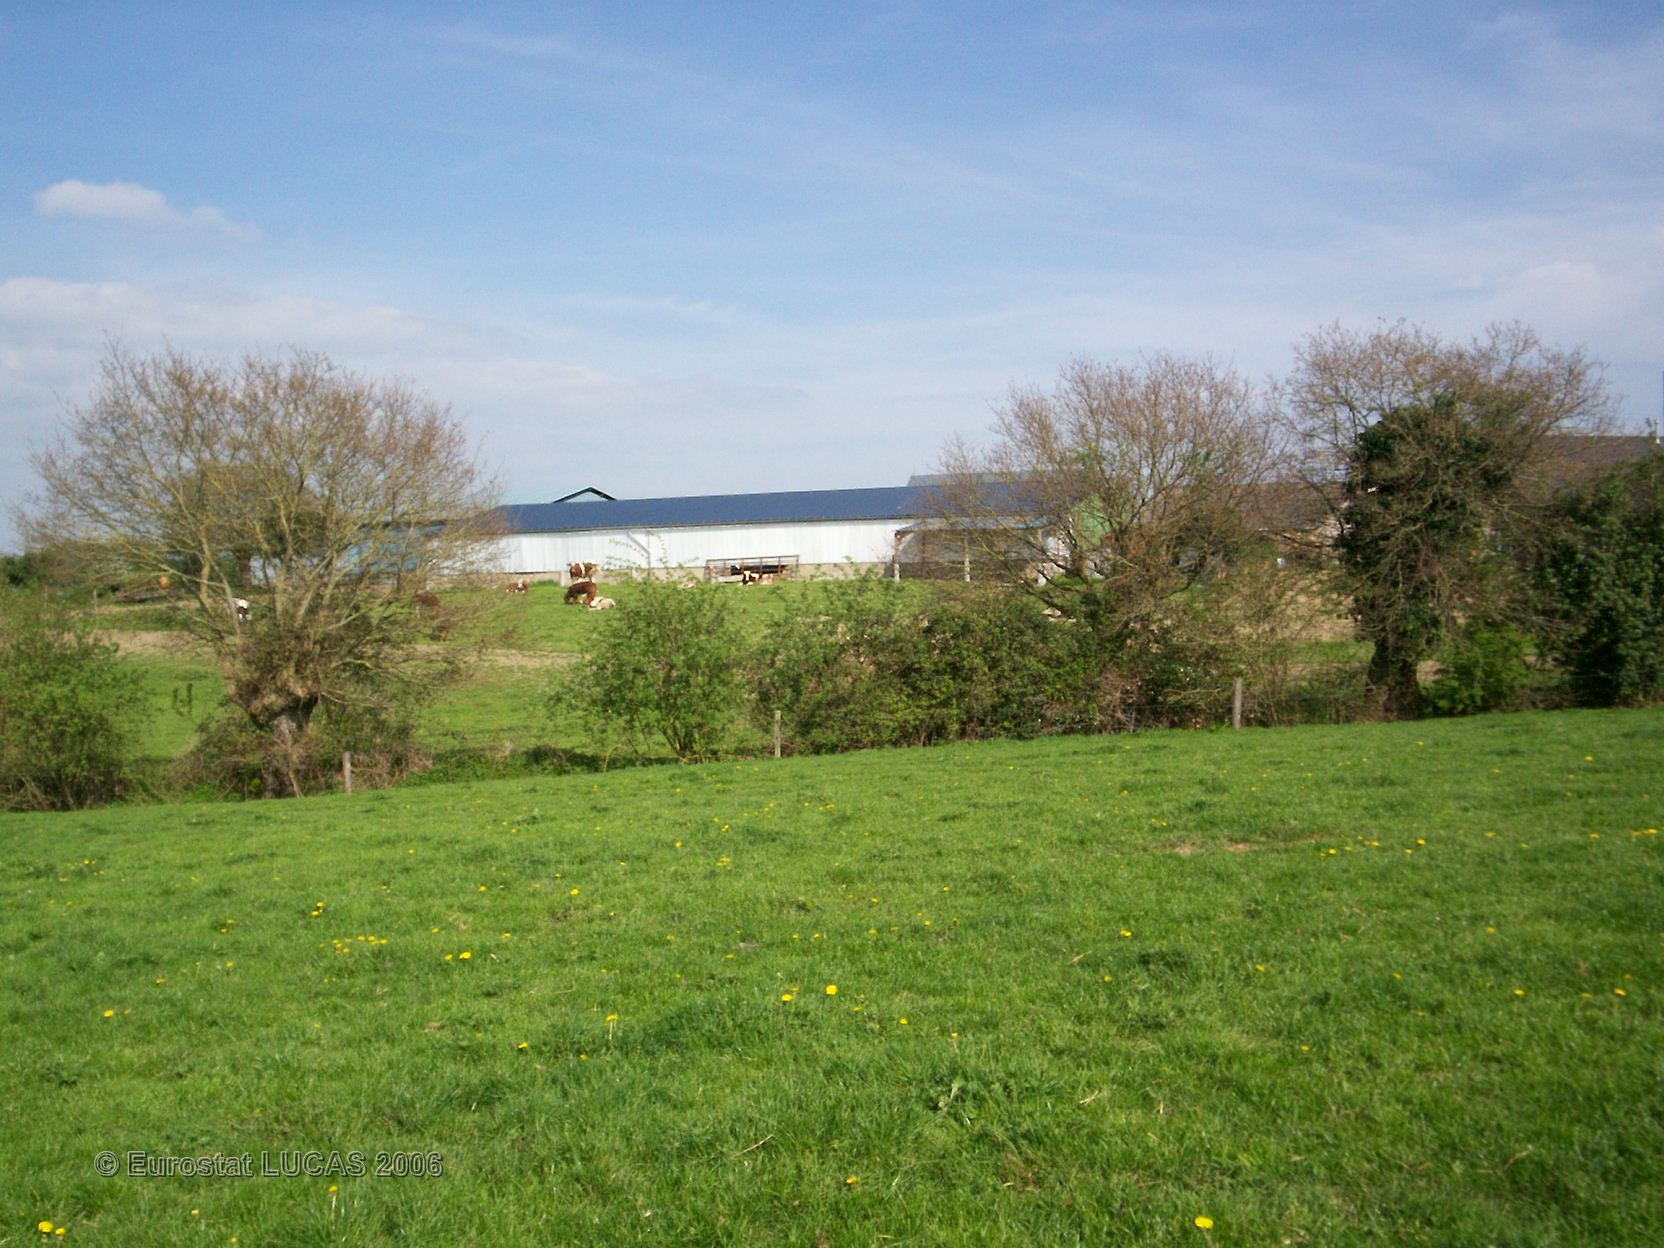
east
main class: Grassland
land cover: Grassland without tree/shrub cover
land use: Agriculture (excluding fallow land and kitchen gardens)
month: April
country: FR
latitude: 48.1452
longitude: -0.2320
